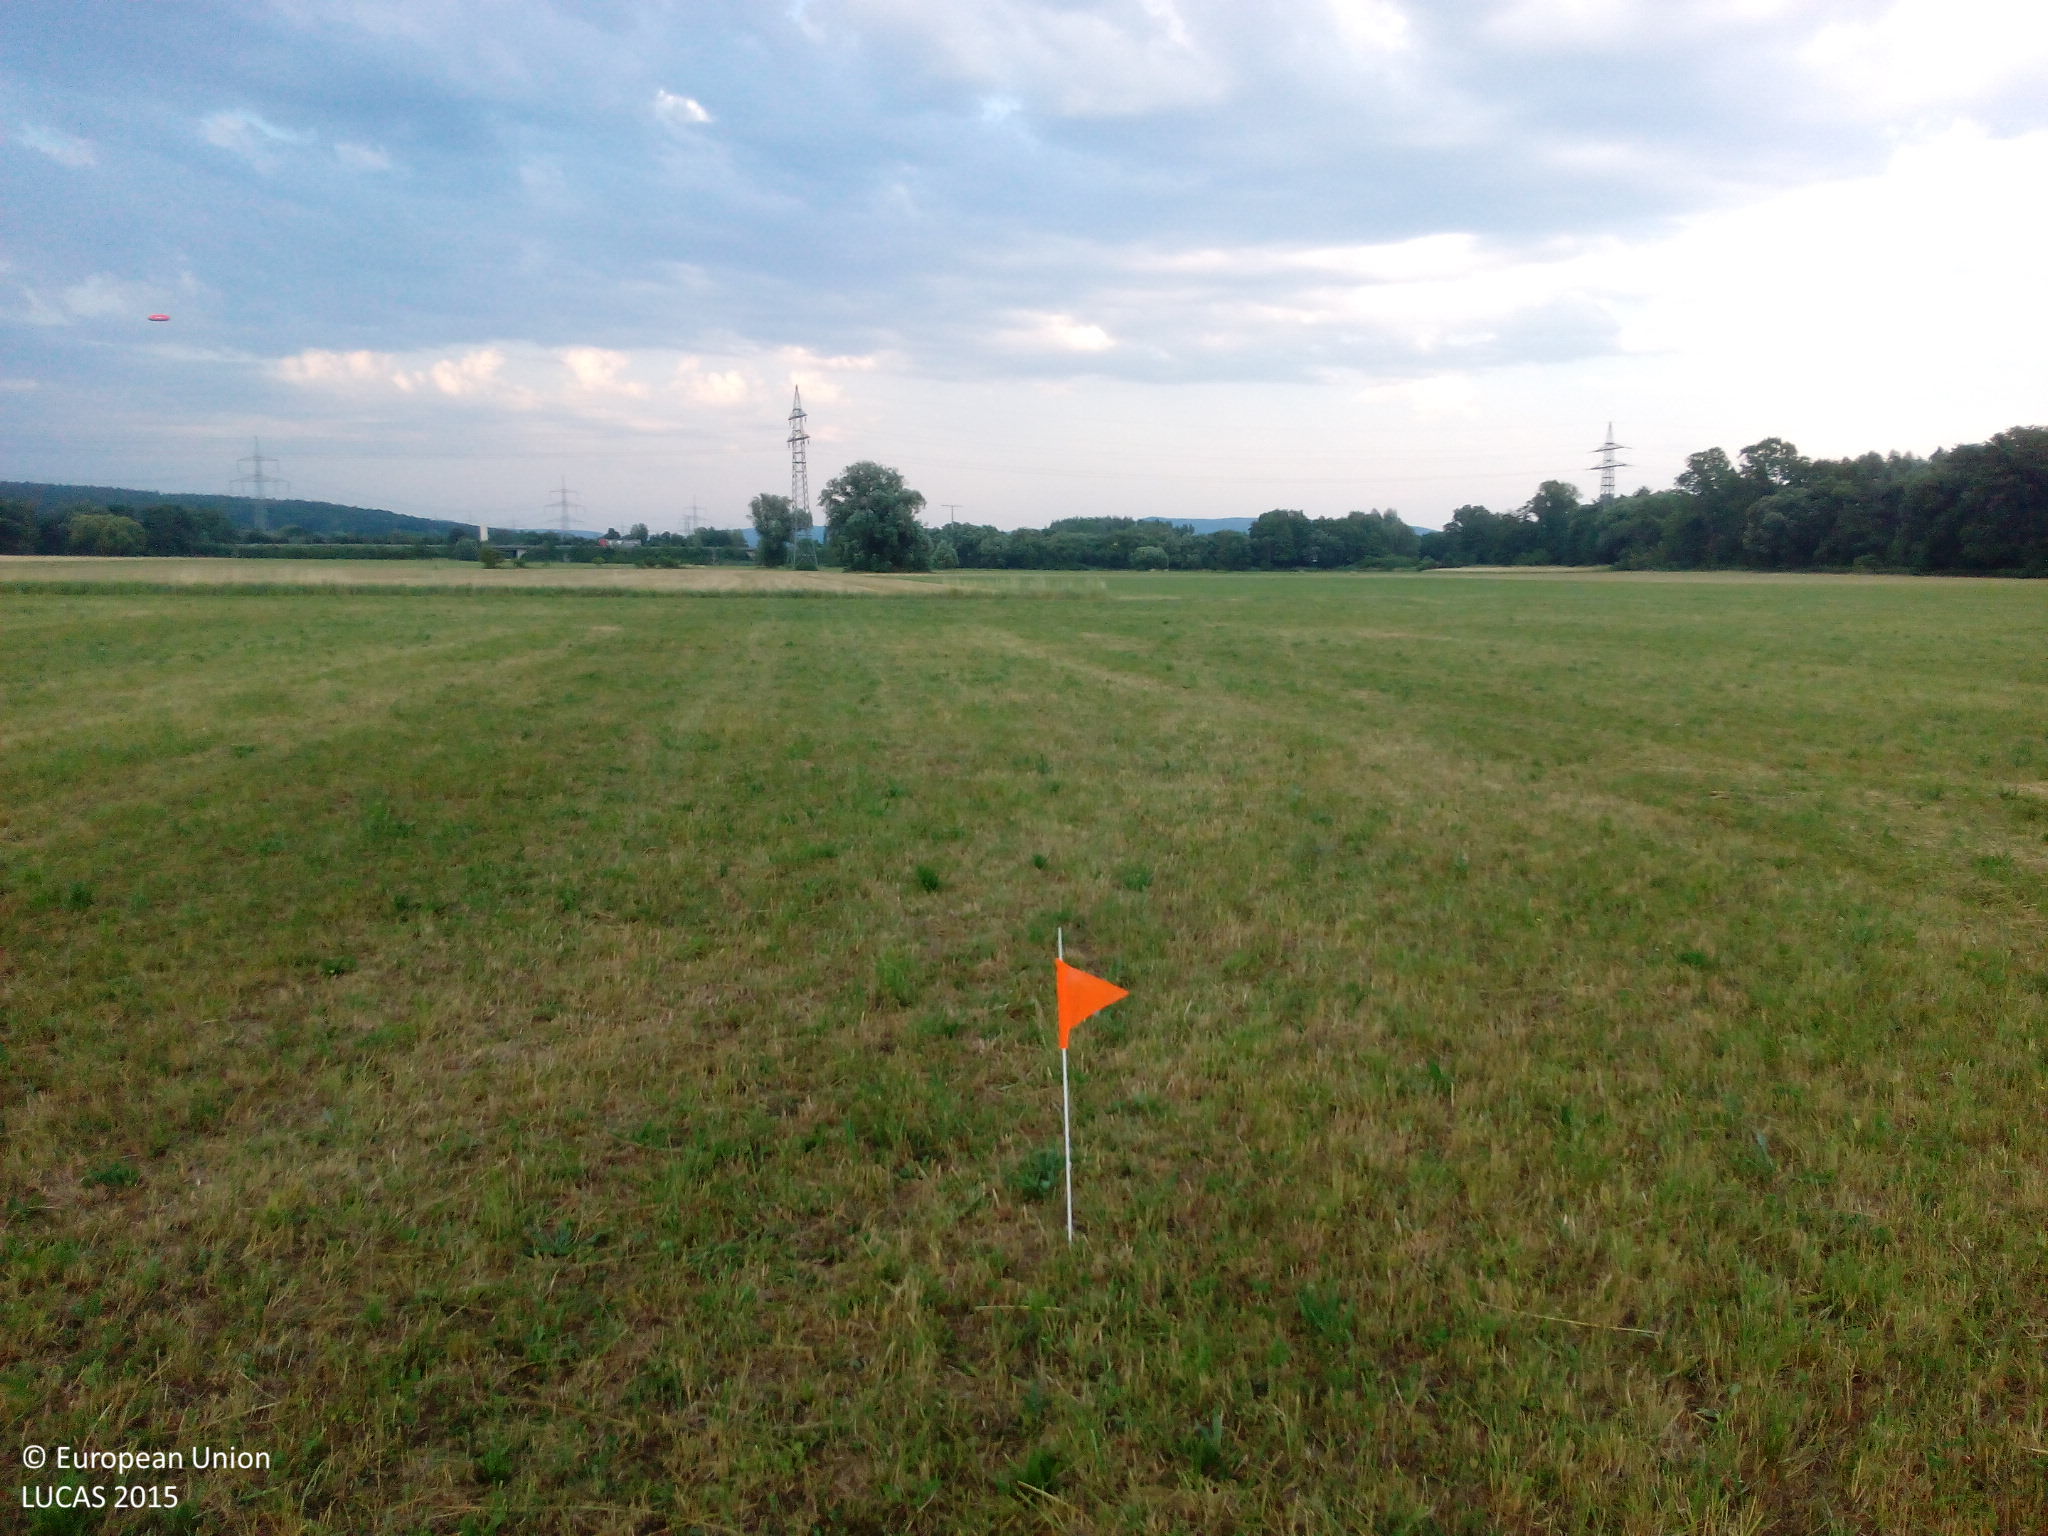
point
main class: Grassland
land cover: Grassland without tree/shrub cover
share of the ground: > 75 %
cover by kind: herbaceous plants 100 %
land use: Agriculture (excluding fallow land and kitchen gardens)
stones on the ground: < 10 %
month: July
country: DE
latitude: 49.9289
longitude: 10.9052
